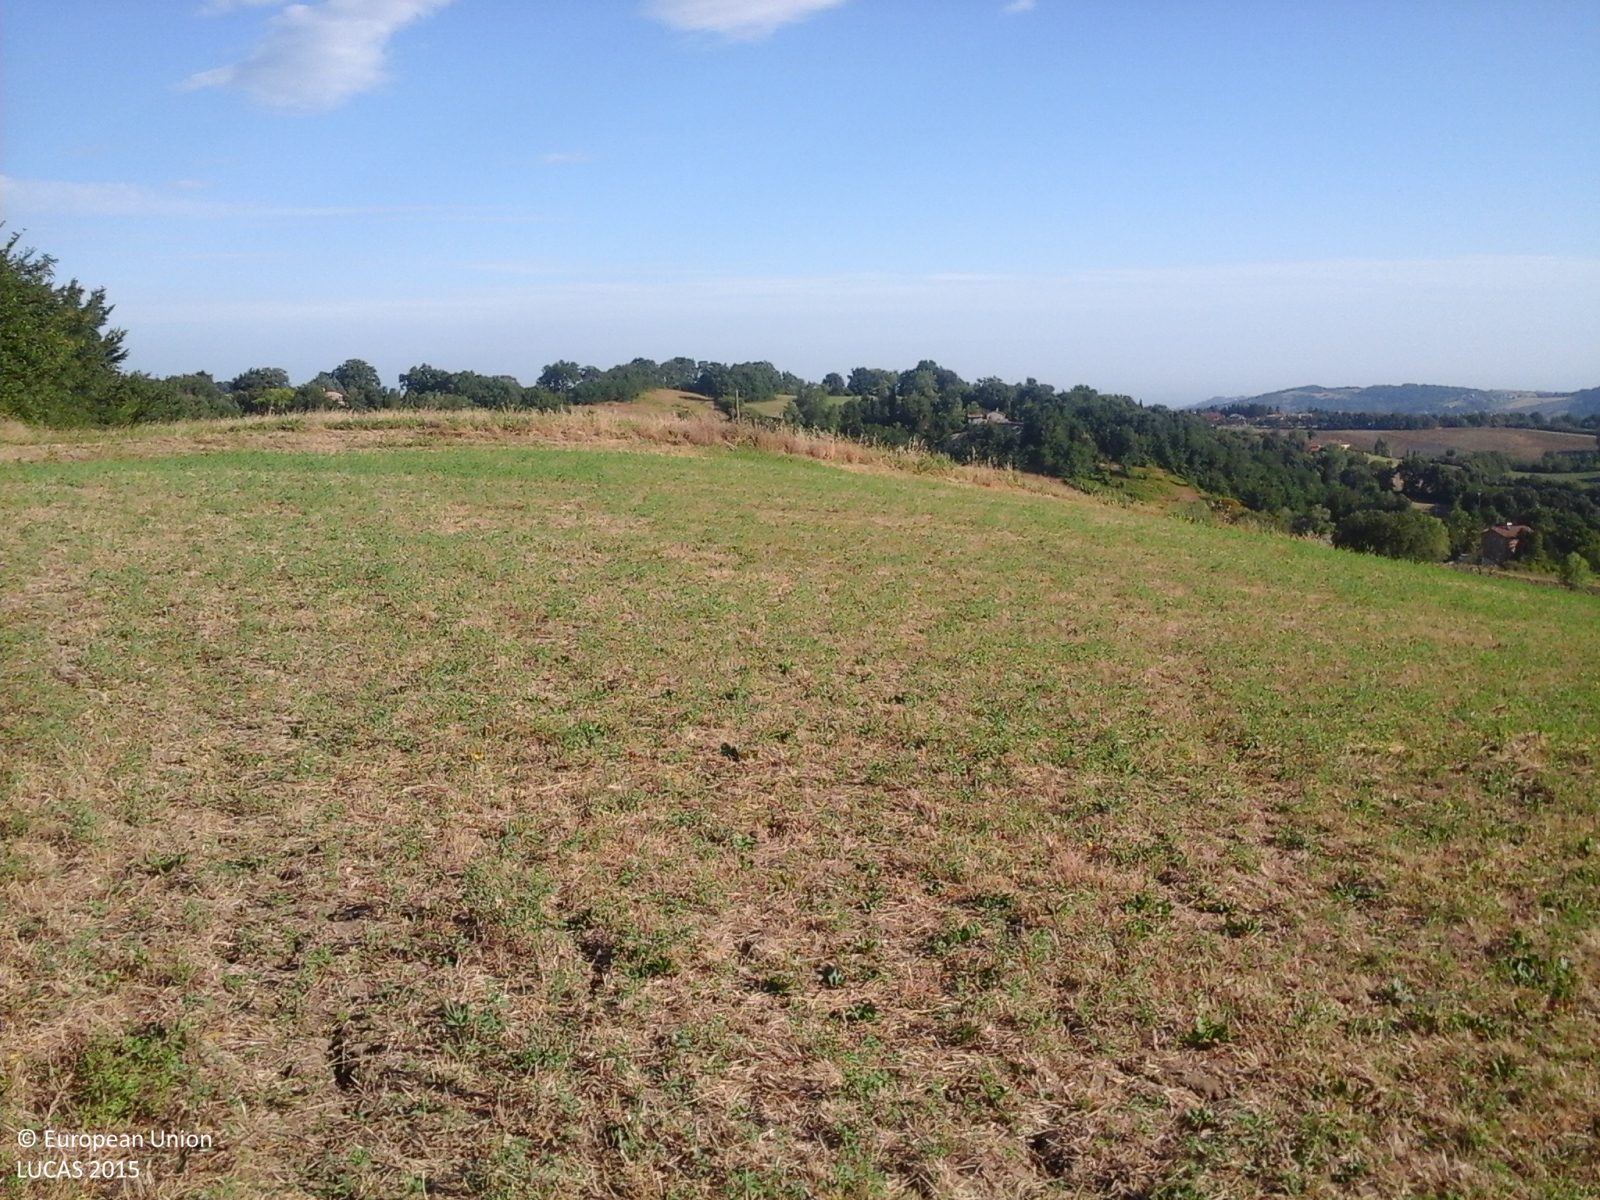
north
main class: Cropland
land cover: Lucerne
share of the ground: > 75 %
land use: Agriculture (excluding fallow land and kitchen gardens)
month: July
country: IT
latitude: 43.8892
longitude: 12.4215
